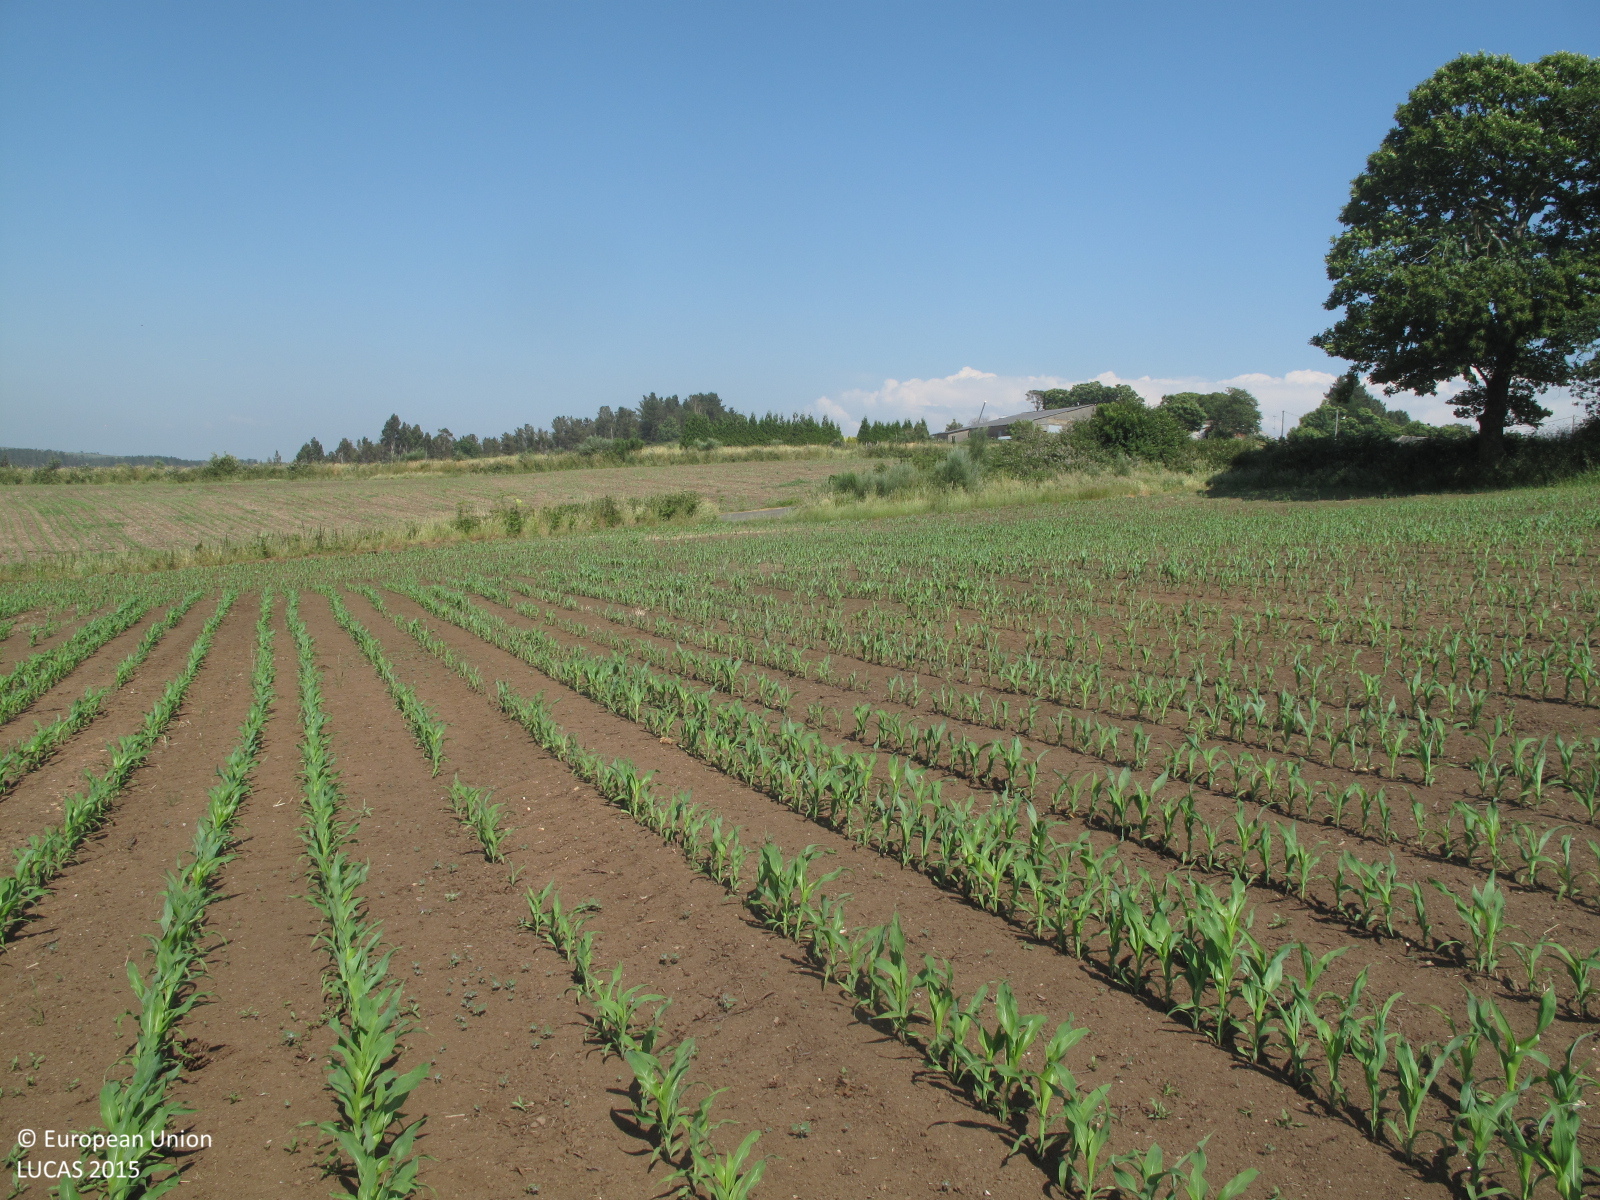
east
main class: Cropland
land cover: Maize
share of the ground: 10 - 25 %
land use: Agriculture (excluding fallow land and kitchen gardens)
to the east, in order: Maize; Shruby margins; Paved roads, cycling and walking lanes; Grass margins; Maize; Grass margins; Paved roads, cycling and walking lanes; Shruby margins; Fences; Maize; Fences; Grassland without tree/shrub cover
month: June
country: ES
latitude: 43.2817
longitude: -7.9735
